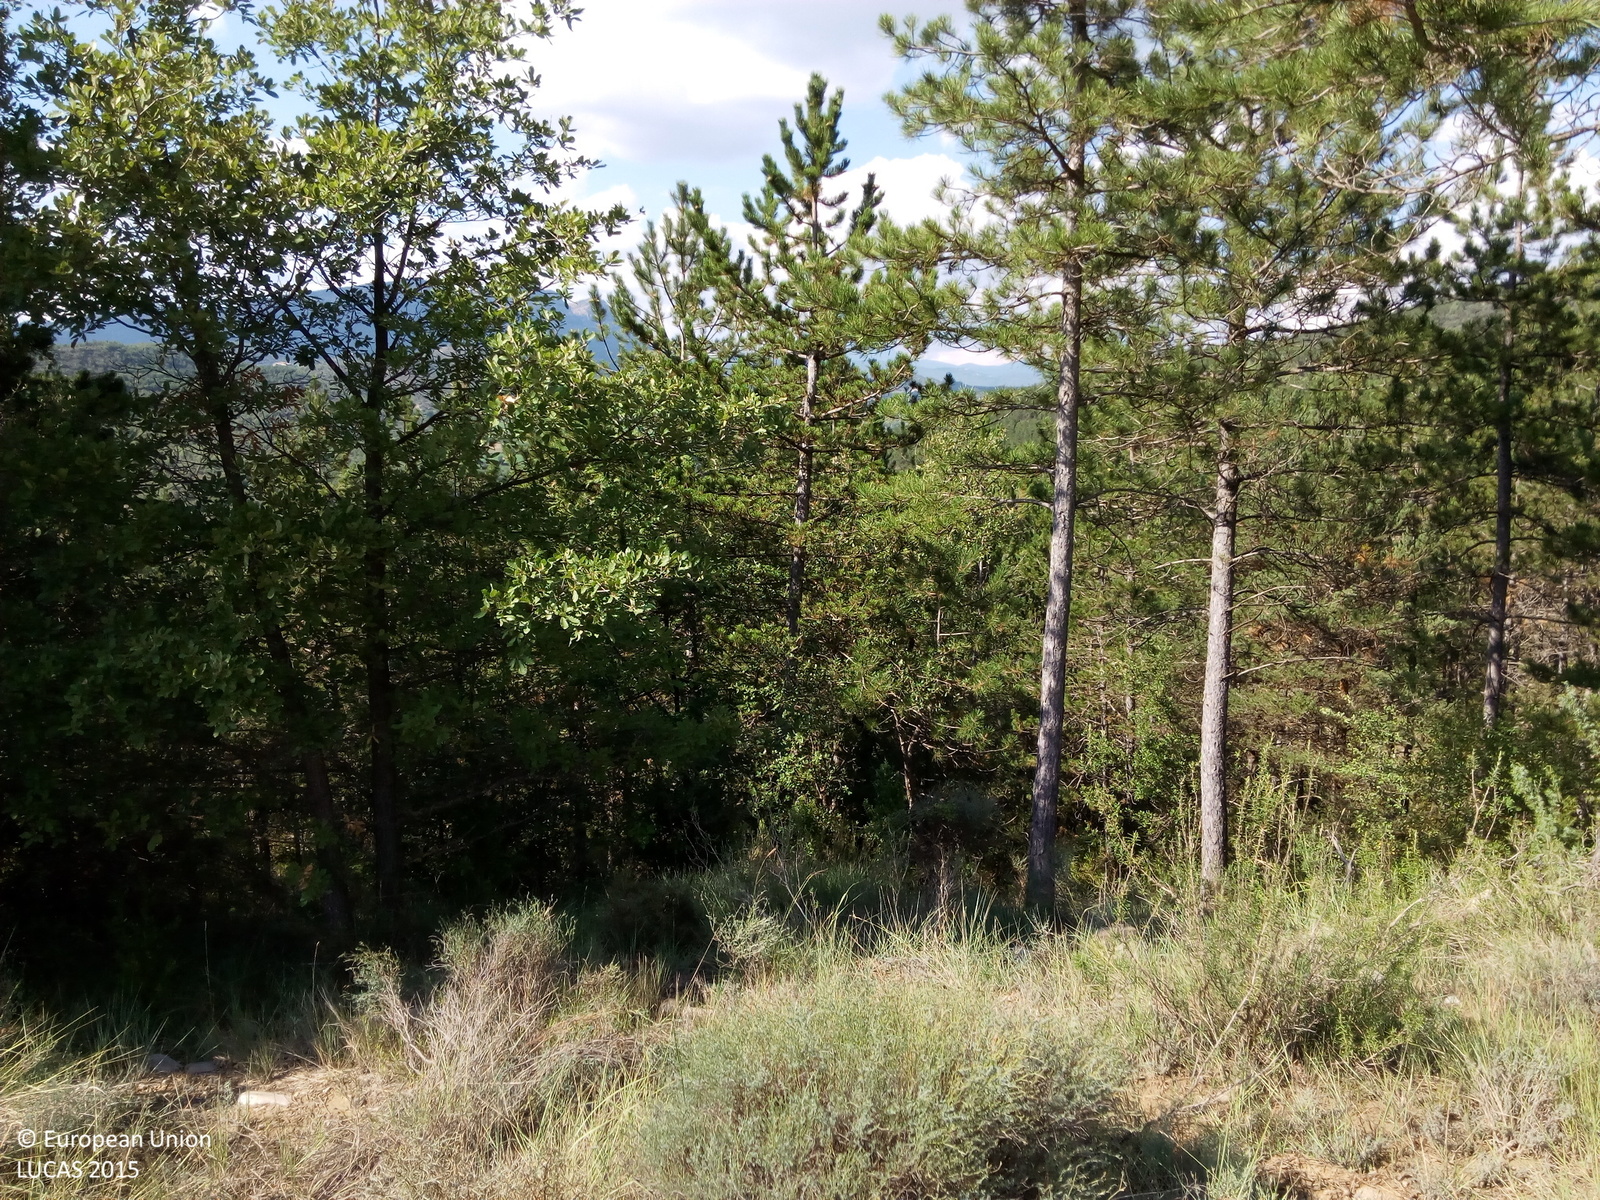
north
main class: Woodland
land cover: Pine dominated mixed woodland
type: coniferous forest of the mediterranean region
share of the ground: > 75 %
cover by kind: coniferous forest trees 50 %, shrubs 30 %, broadleaved forest trees 20 %
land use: Forestry
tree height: > 5 m
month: August
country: ES
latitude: 42.2266
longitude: 0.5200
